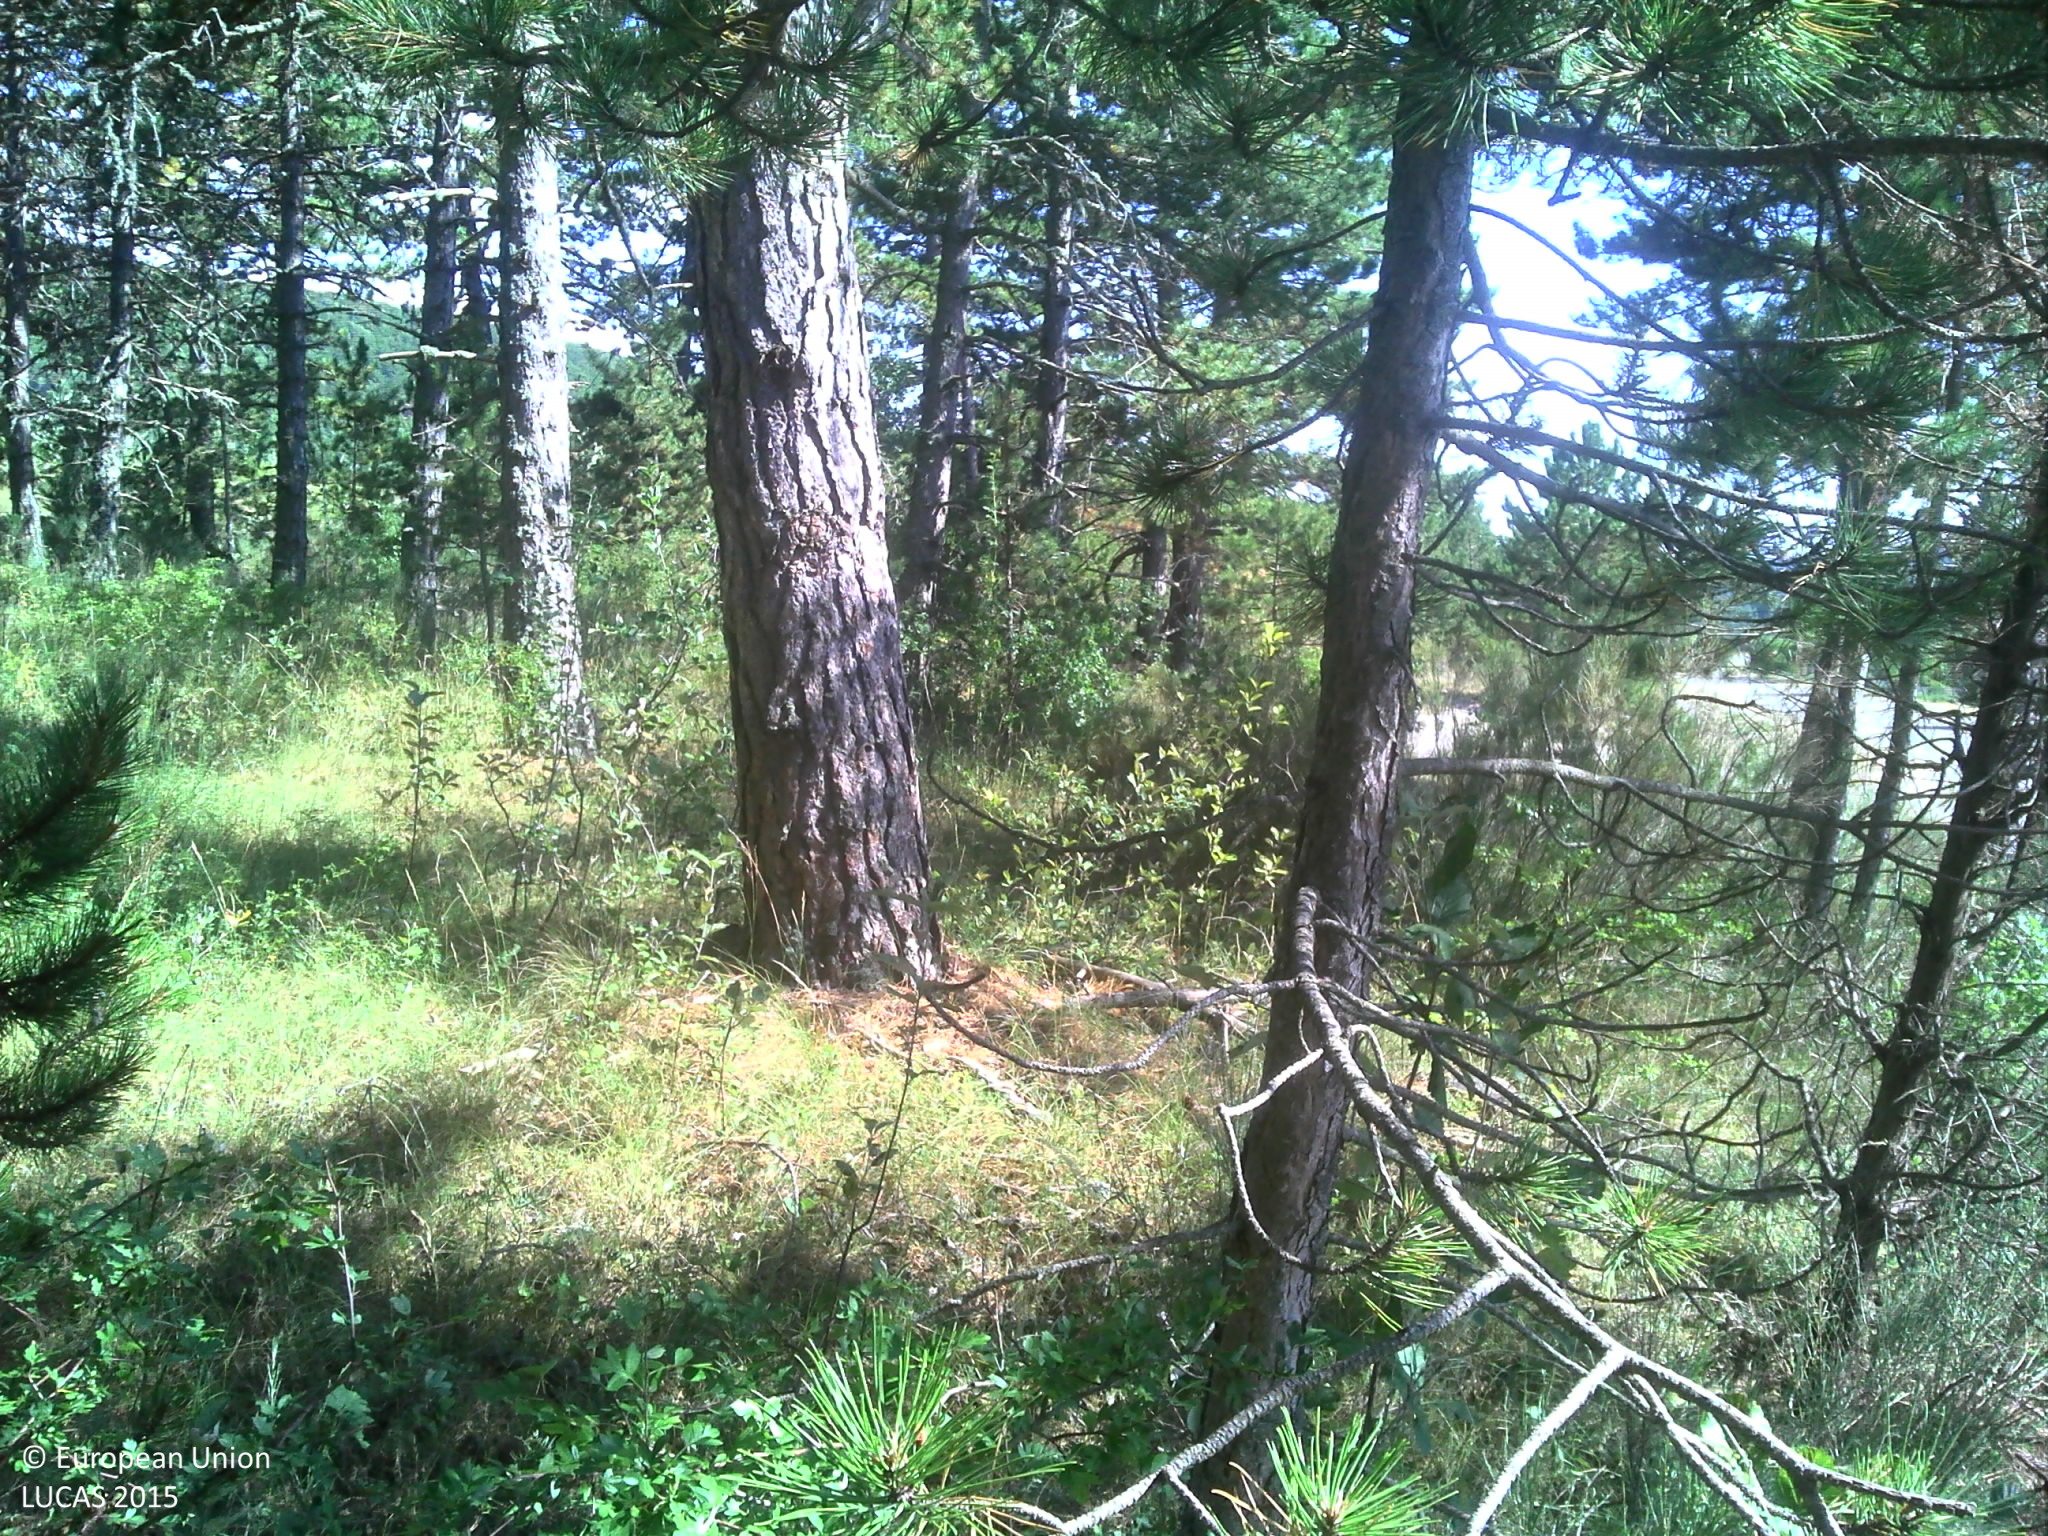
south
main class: Woodland
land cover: Pine dominated coniferous woodland
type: coniferous forest of the mediterranean region
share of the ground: > 75 %
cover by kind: coniferous forest trees 65 %
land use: Forestry
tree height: > 5 m
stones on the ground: < 10 %
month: July
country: FR
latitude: 44.1476
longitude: 5.5697
